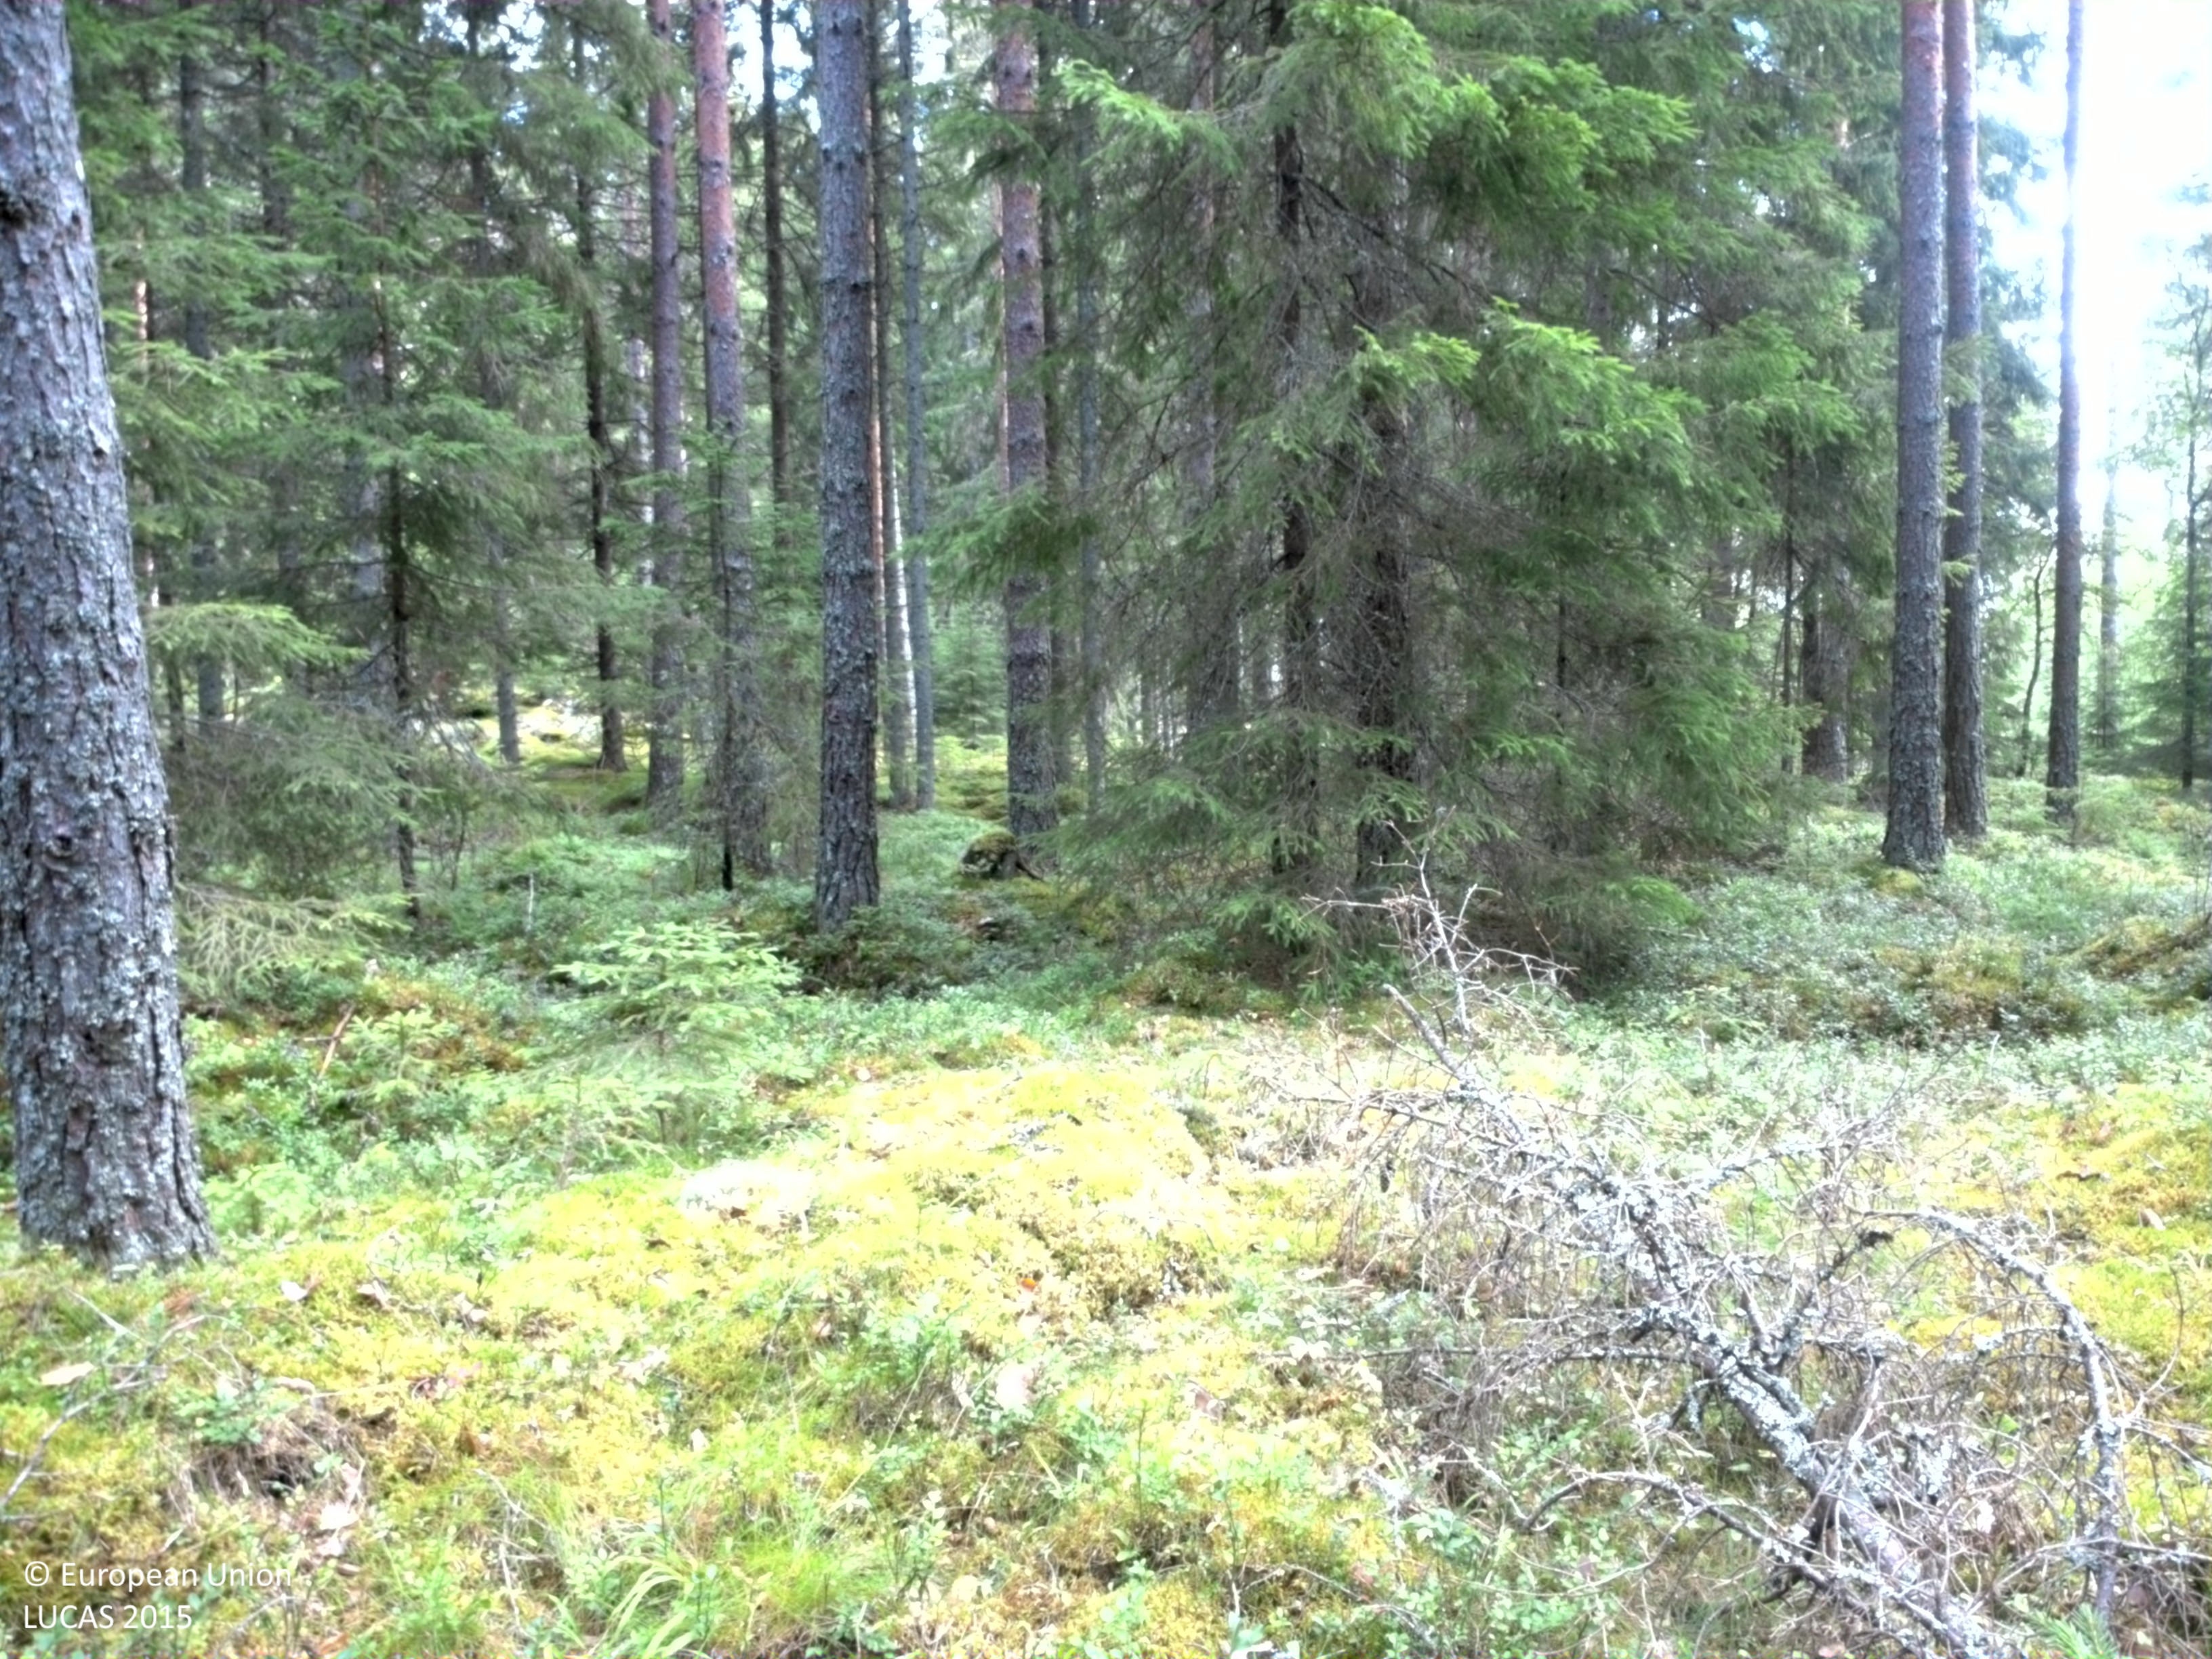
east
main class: Woodland
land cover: Pine dominated coniferous woodland
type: boreal forest
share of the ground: 50 - 75 %
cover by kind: coniferous forest trees 55 %, shrubs 20 %, lichens and mosses 20 %, broadleaved forest trees 5 %
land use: Forestry
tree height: > 5 m
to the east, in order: Pine dominated coniferous woodland; Spruce dominated coniferous woodland; Tracks; Spruce dominated mixed woodland; Spruce dominated coniferous woodland; Pine dominated coniferous woodland
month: July
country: SE
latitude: 59.4475
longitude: 11.9174
